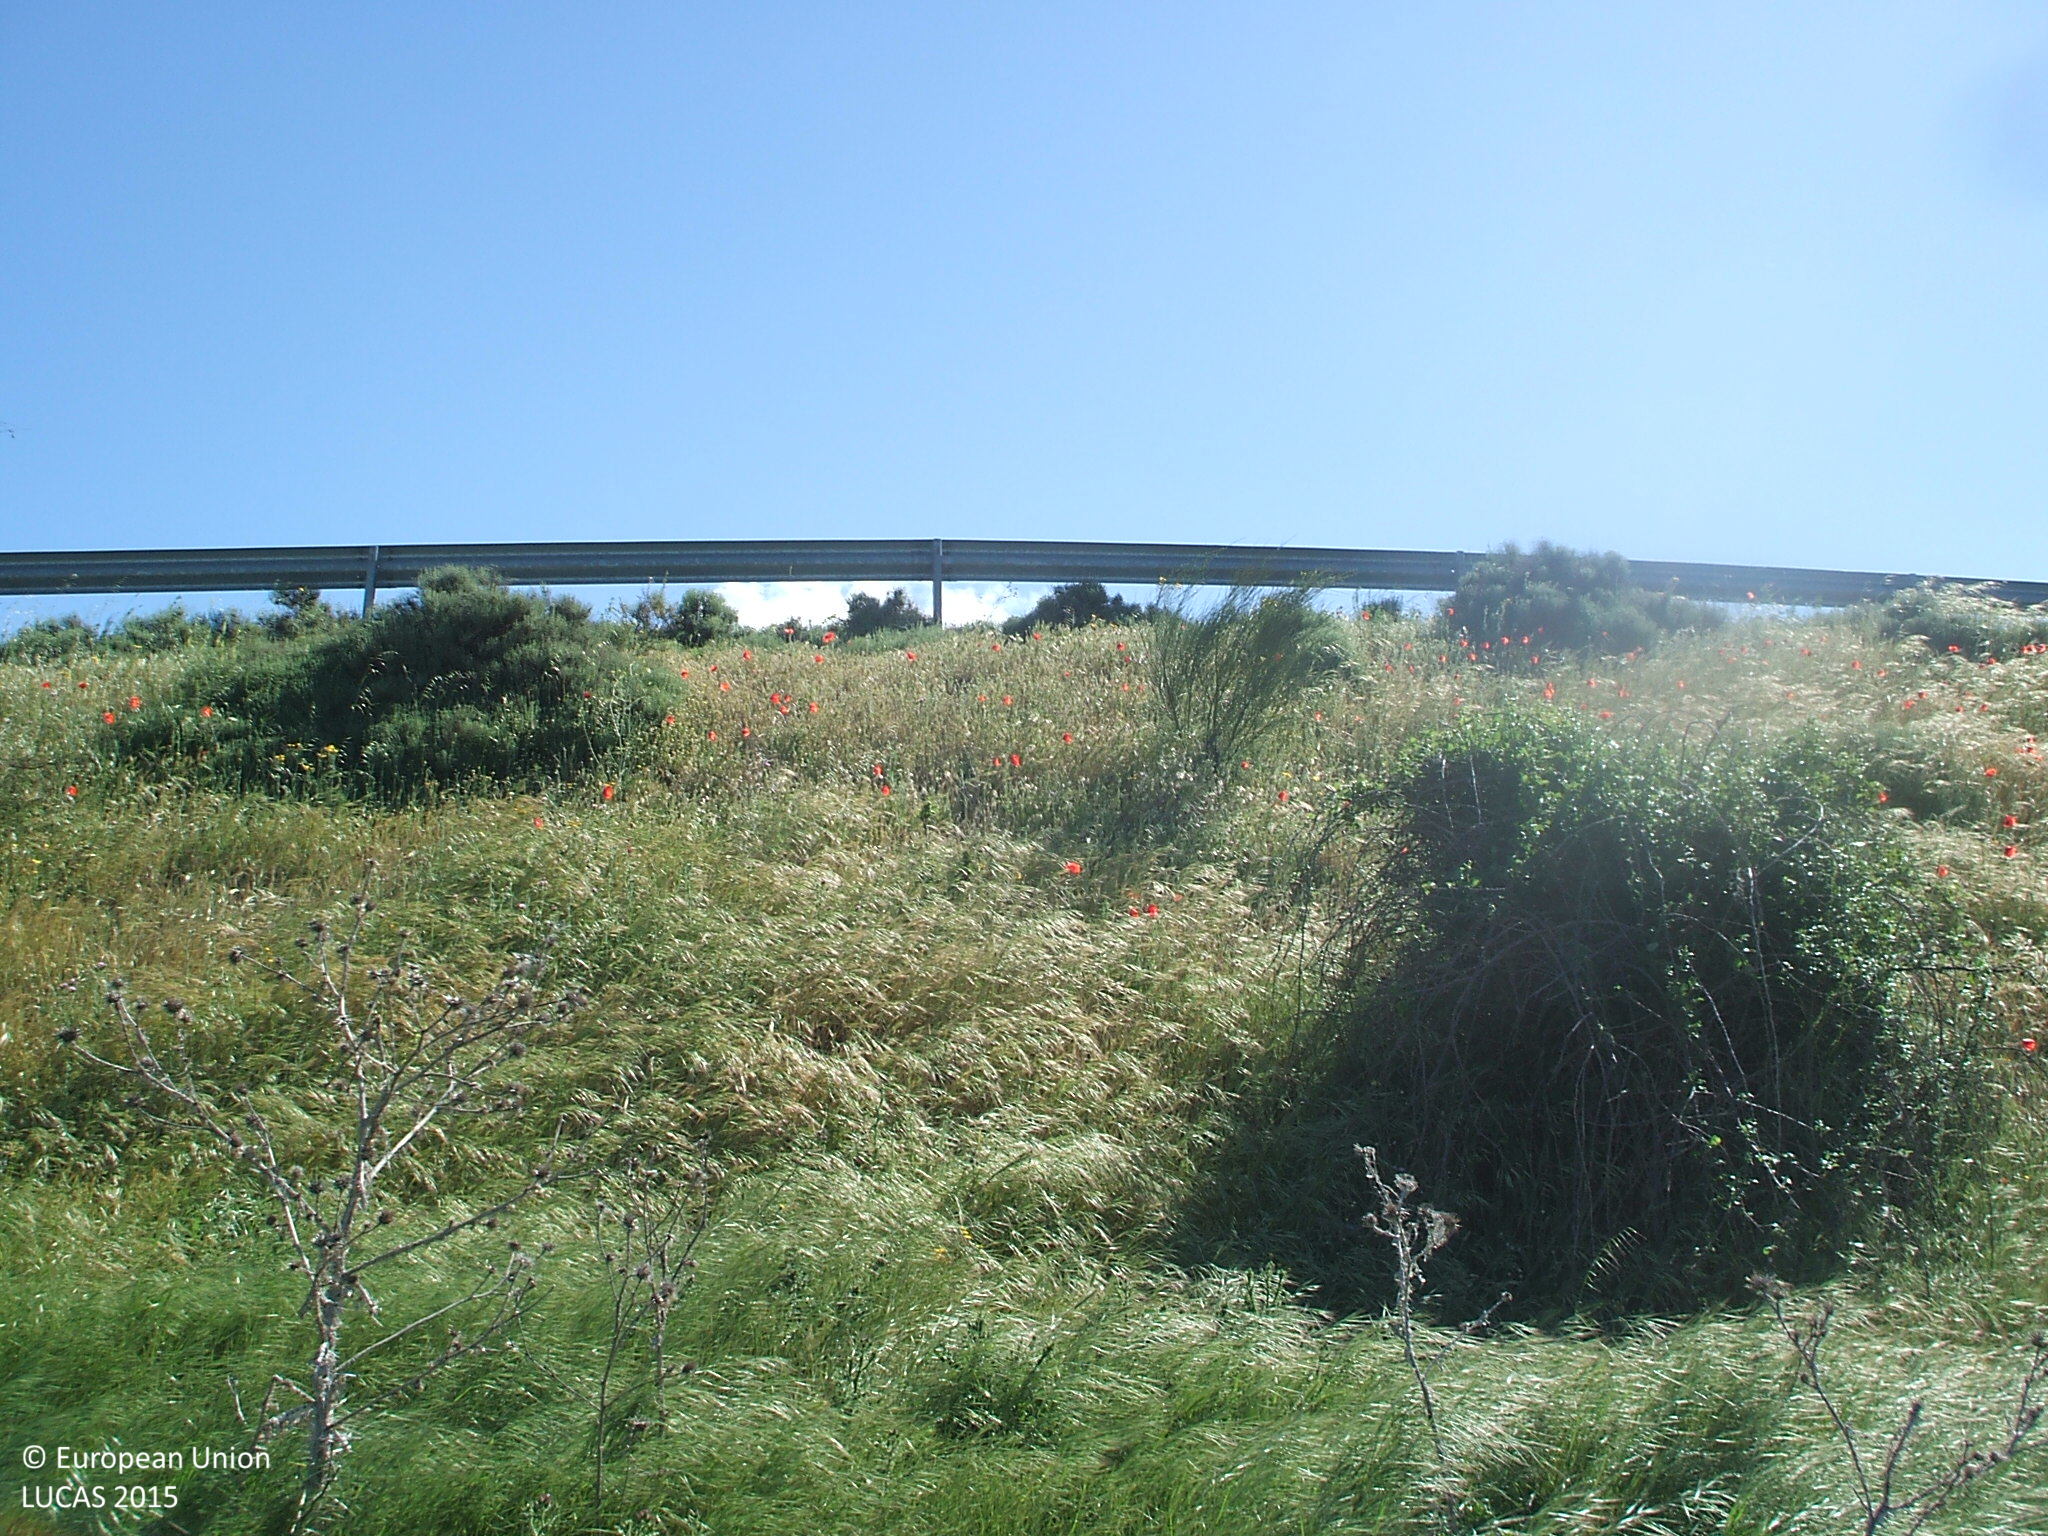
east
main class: Grassland
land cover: Grassland without tree/shrub cover
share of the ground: > 75 %
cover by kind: herbaceous plants 95 %, shrubs 5 %
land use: Semi-natural and natural areas not in use
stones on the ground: > 50 %
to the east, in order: Grassland without tree/shrub cover; Paved roads, cycling and walking lanes; Shrubland without tree cover; Fences; Electric lines; Railways; Electric lines; Fences; Grassland without tree/shrub cover; Barley; Abandoned hedges; Barley; Broadleaved woodland; Shrubland with sparse tree cover; Broadleaved woodland; Barley
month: May
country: ES
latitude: 40.8207
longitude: -2.8967
